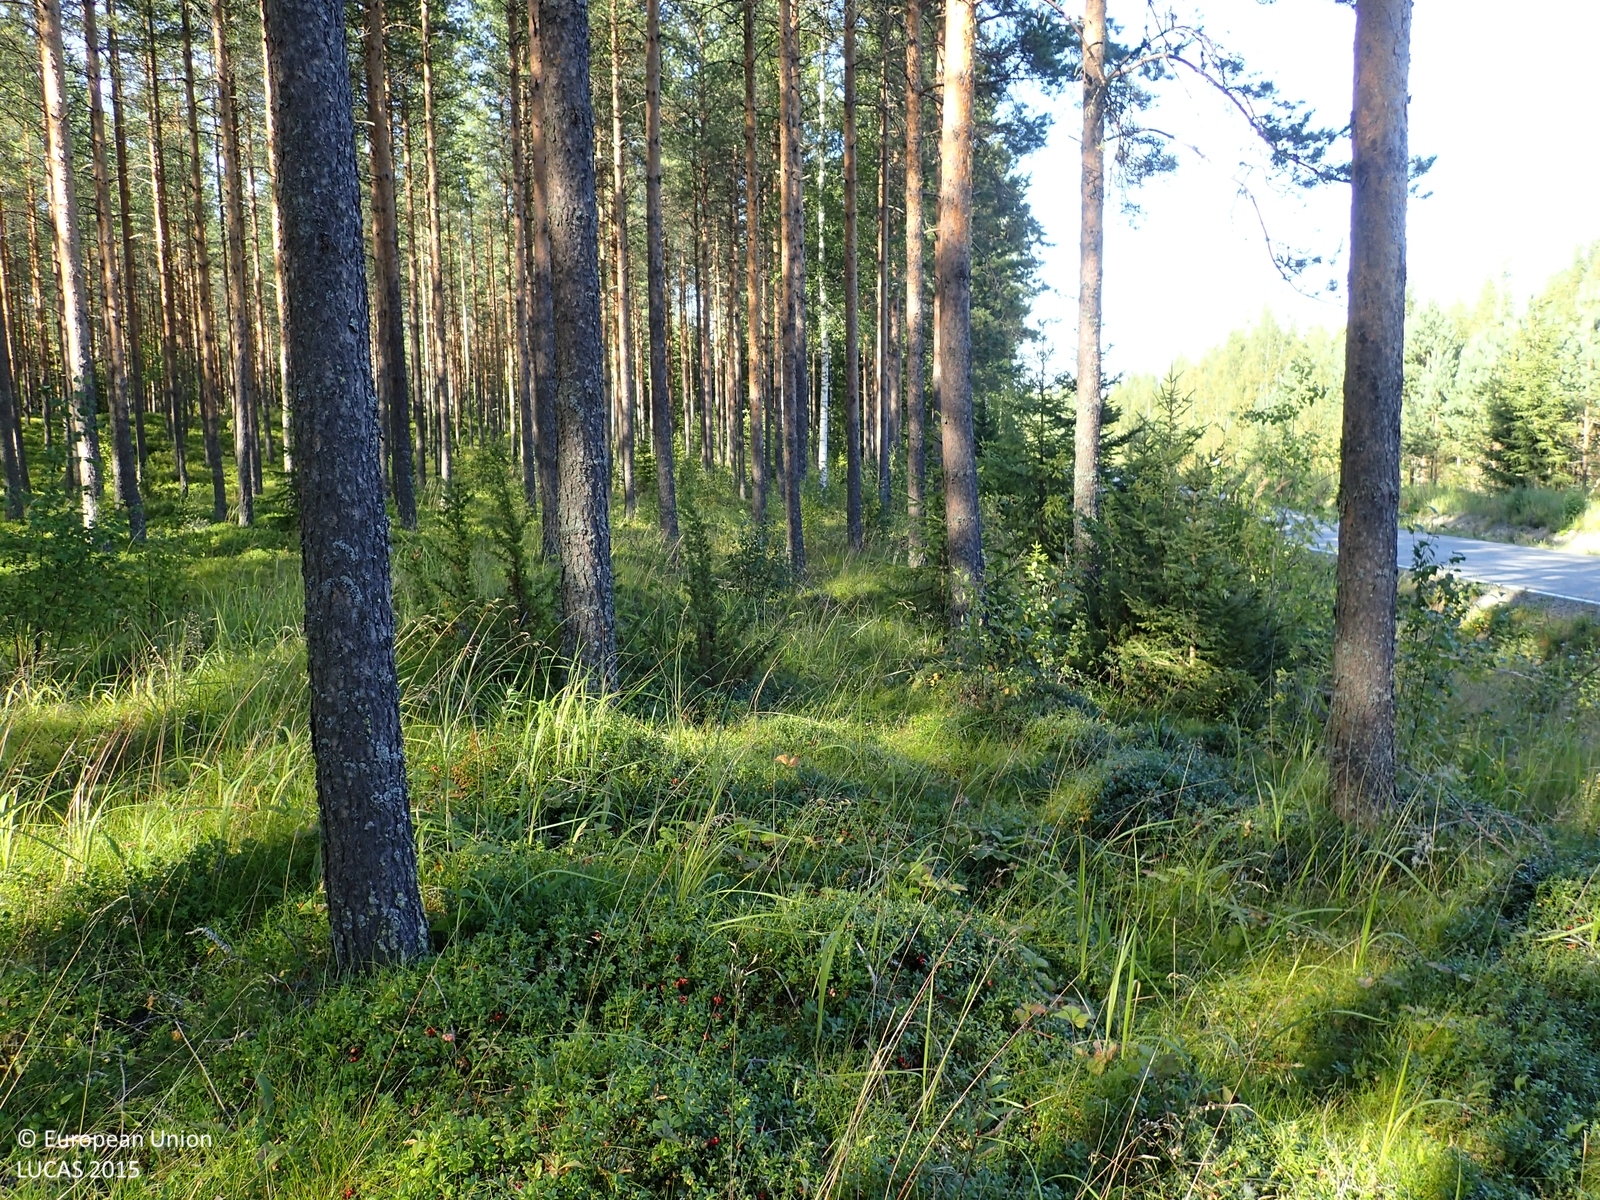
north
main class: Woodland
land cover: Pine dominated coniferous woodland
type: boreal forest
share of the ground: > 75 %
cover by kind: coniferous forest trees 75 %, shrubs 20 %, herbaceous plants 5 %
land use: Forestry
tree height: > 5 m
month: August
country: FI
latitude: 62.4384
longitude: 21.8065
